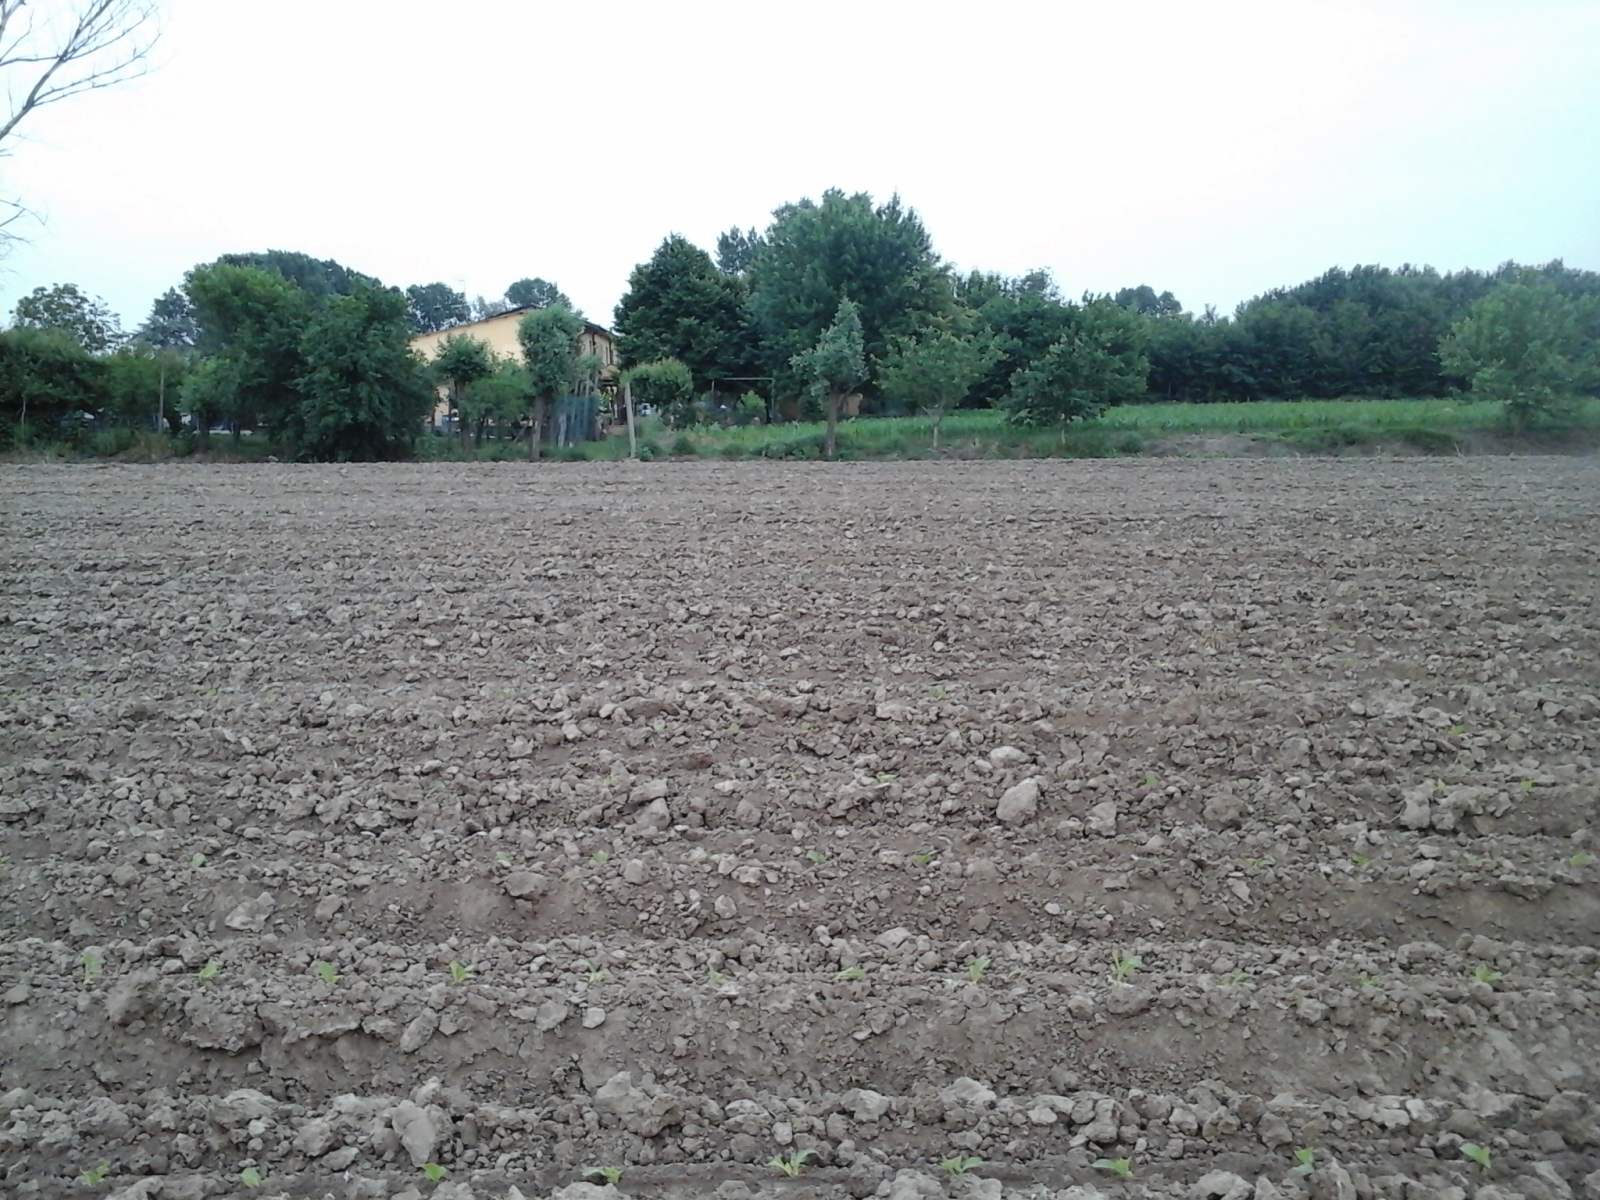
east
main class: Cropland
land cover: Tobacco
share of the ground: < 10 %
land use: Agriculture (excluding fallow land and kitchen gardens)
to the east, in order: Tobacco; Electric lines; Tobacco; Ditches and canals; Fences; Other fruit trees and berries; Artificial constructions in urban areas; Other fresh vegetables; Fences; Grassland without tree/shrub cover; Maize; Fences; Grassland with sparse tree/shrub cover; Tracks; Grassland with sparse tree/shrub cover; Electric lines; Managed hedges; Fences; Electric lines; Ditches and canals; Durum wheat; Lines of trees; Ditches and canals; Tracks; Inland fresh running water; Durum wheat
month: May
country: IT
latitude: 45.2405
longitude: 11.5642
